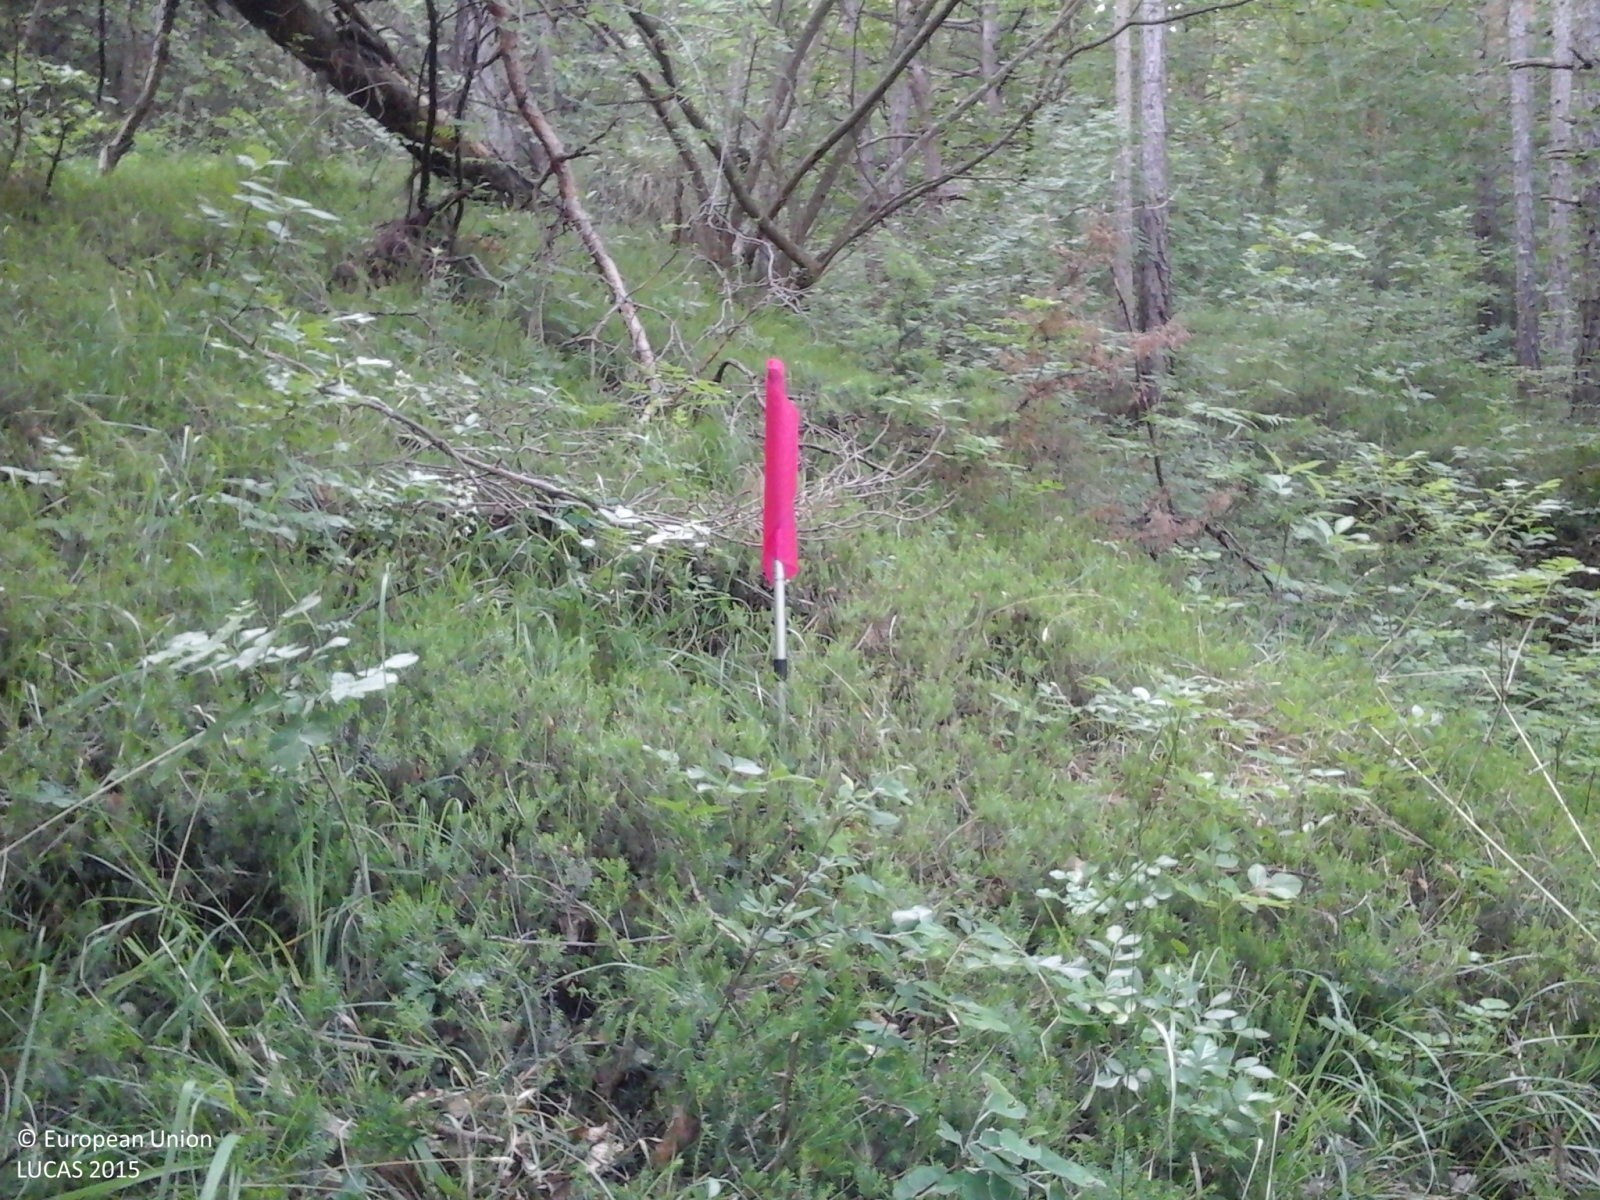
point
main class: Woodland
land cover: Other mixed woodland
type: mountainous beech forest
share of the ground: > 75 %
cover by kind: broadleaved forest trees 60 %, coniferous forest trees 40 %
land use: Forestry
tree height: > 5 m
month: June
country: IT
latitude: 46.0223
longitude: 10.9932
